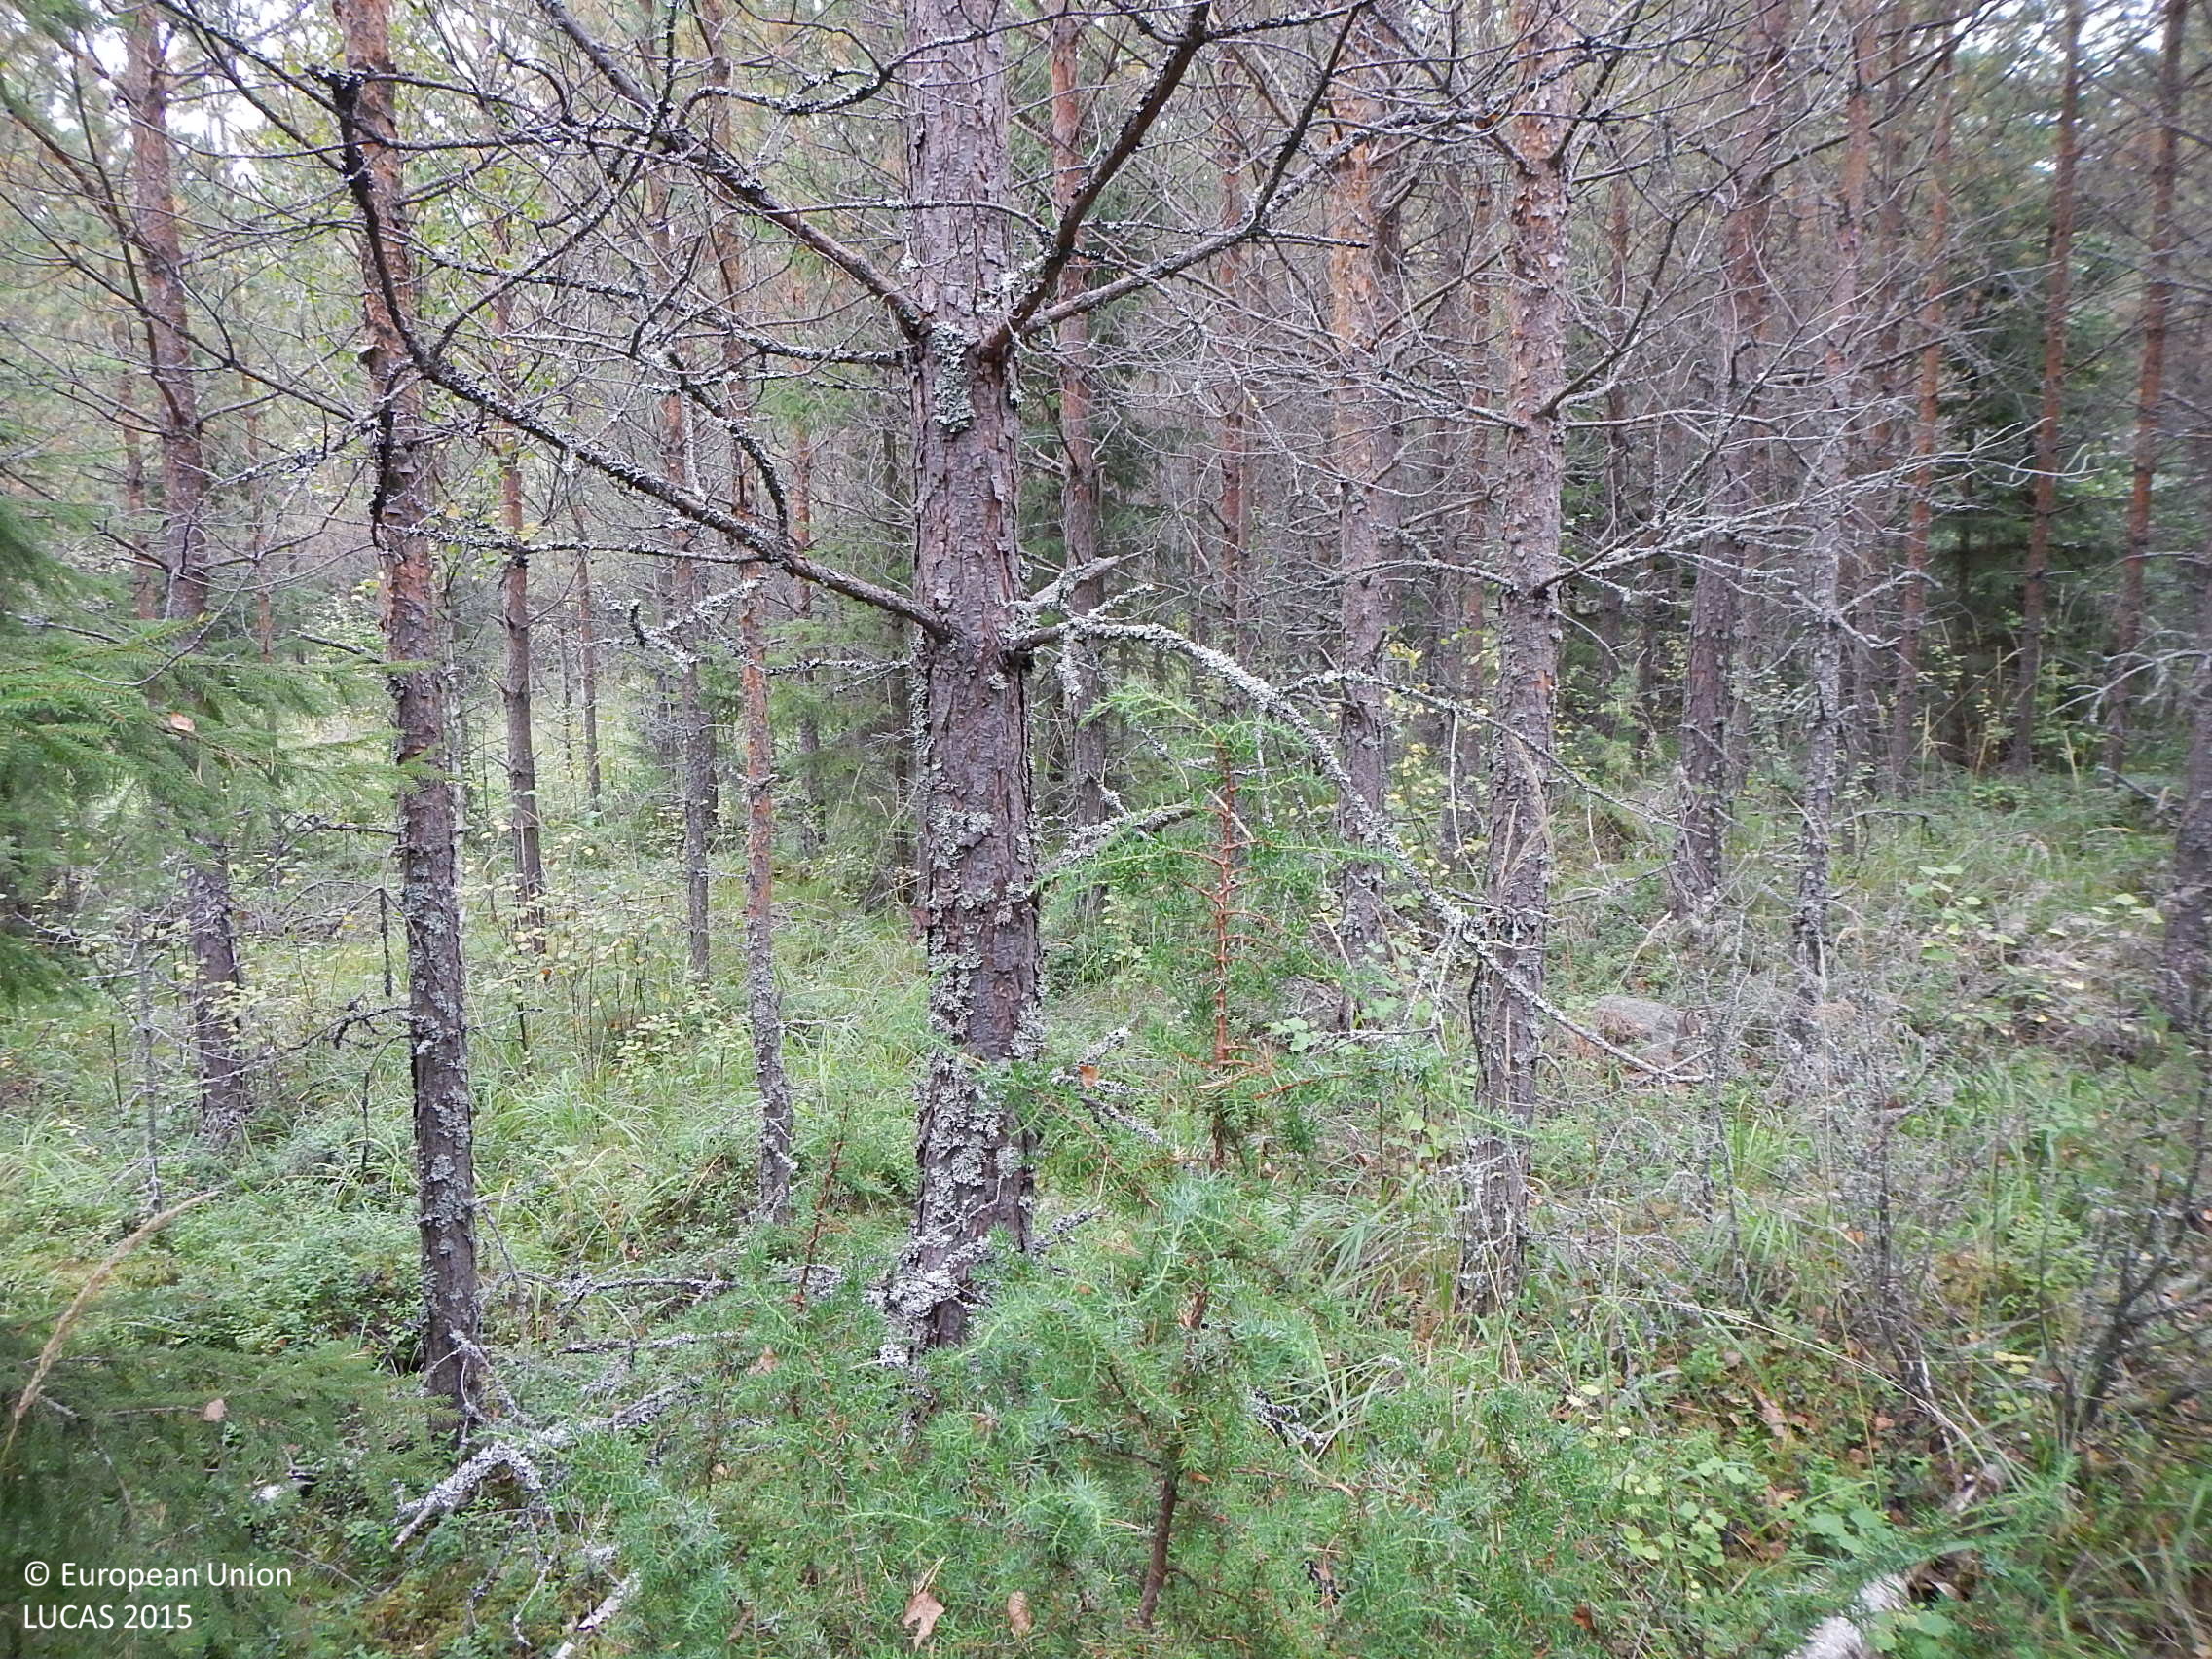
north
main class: Woodland
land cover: Other coniferous woodland
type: boreal forest
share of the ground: > 75 %
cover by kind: coniferous forest trees 60 %, broadleaved forest trees 15 %, shrubs 15 %, herbaceous plants 5 %, lichens and mosses 5 %
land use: Forestry
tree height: > 5 m
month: September
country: FI
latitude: 61.5426
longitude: 22.0404
